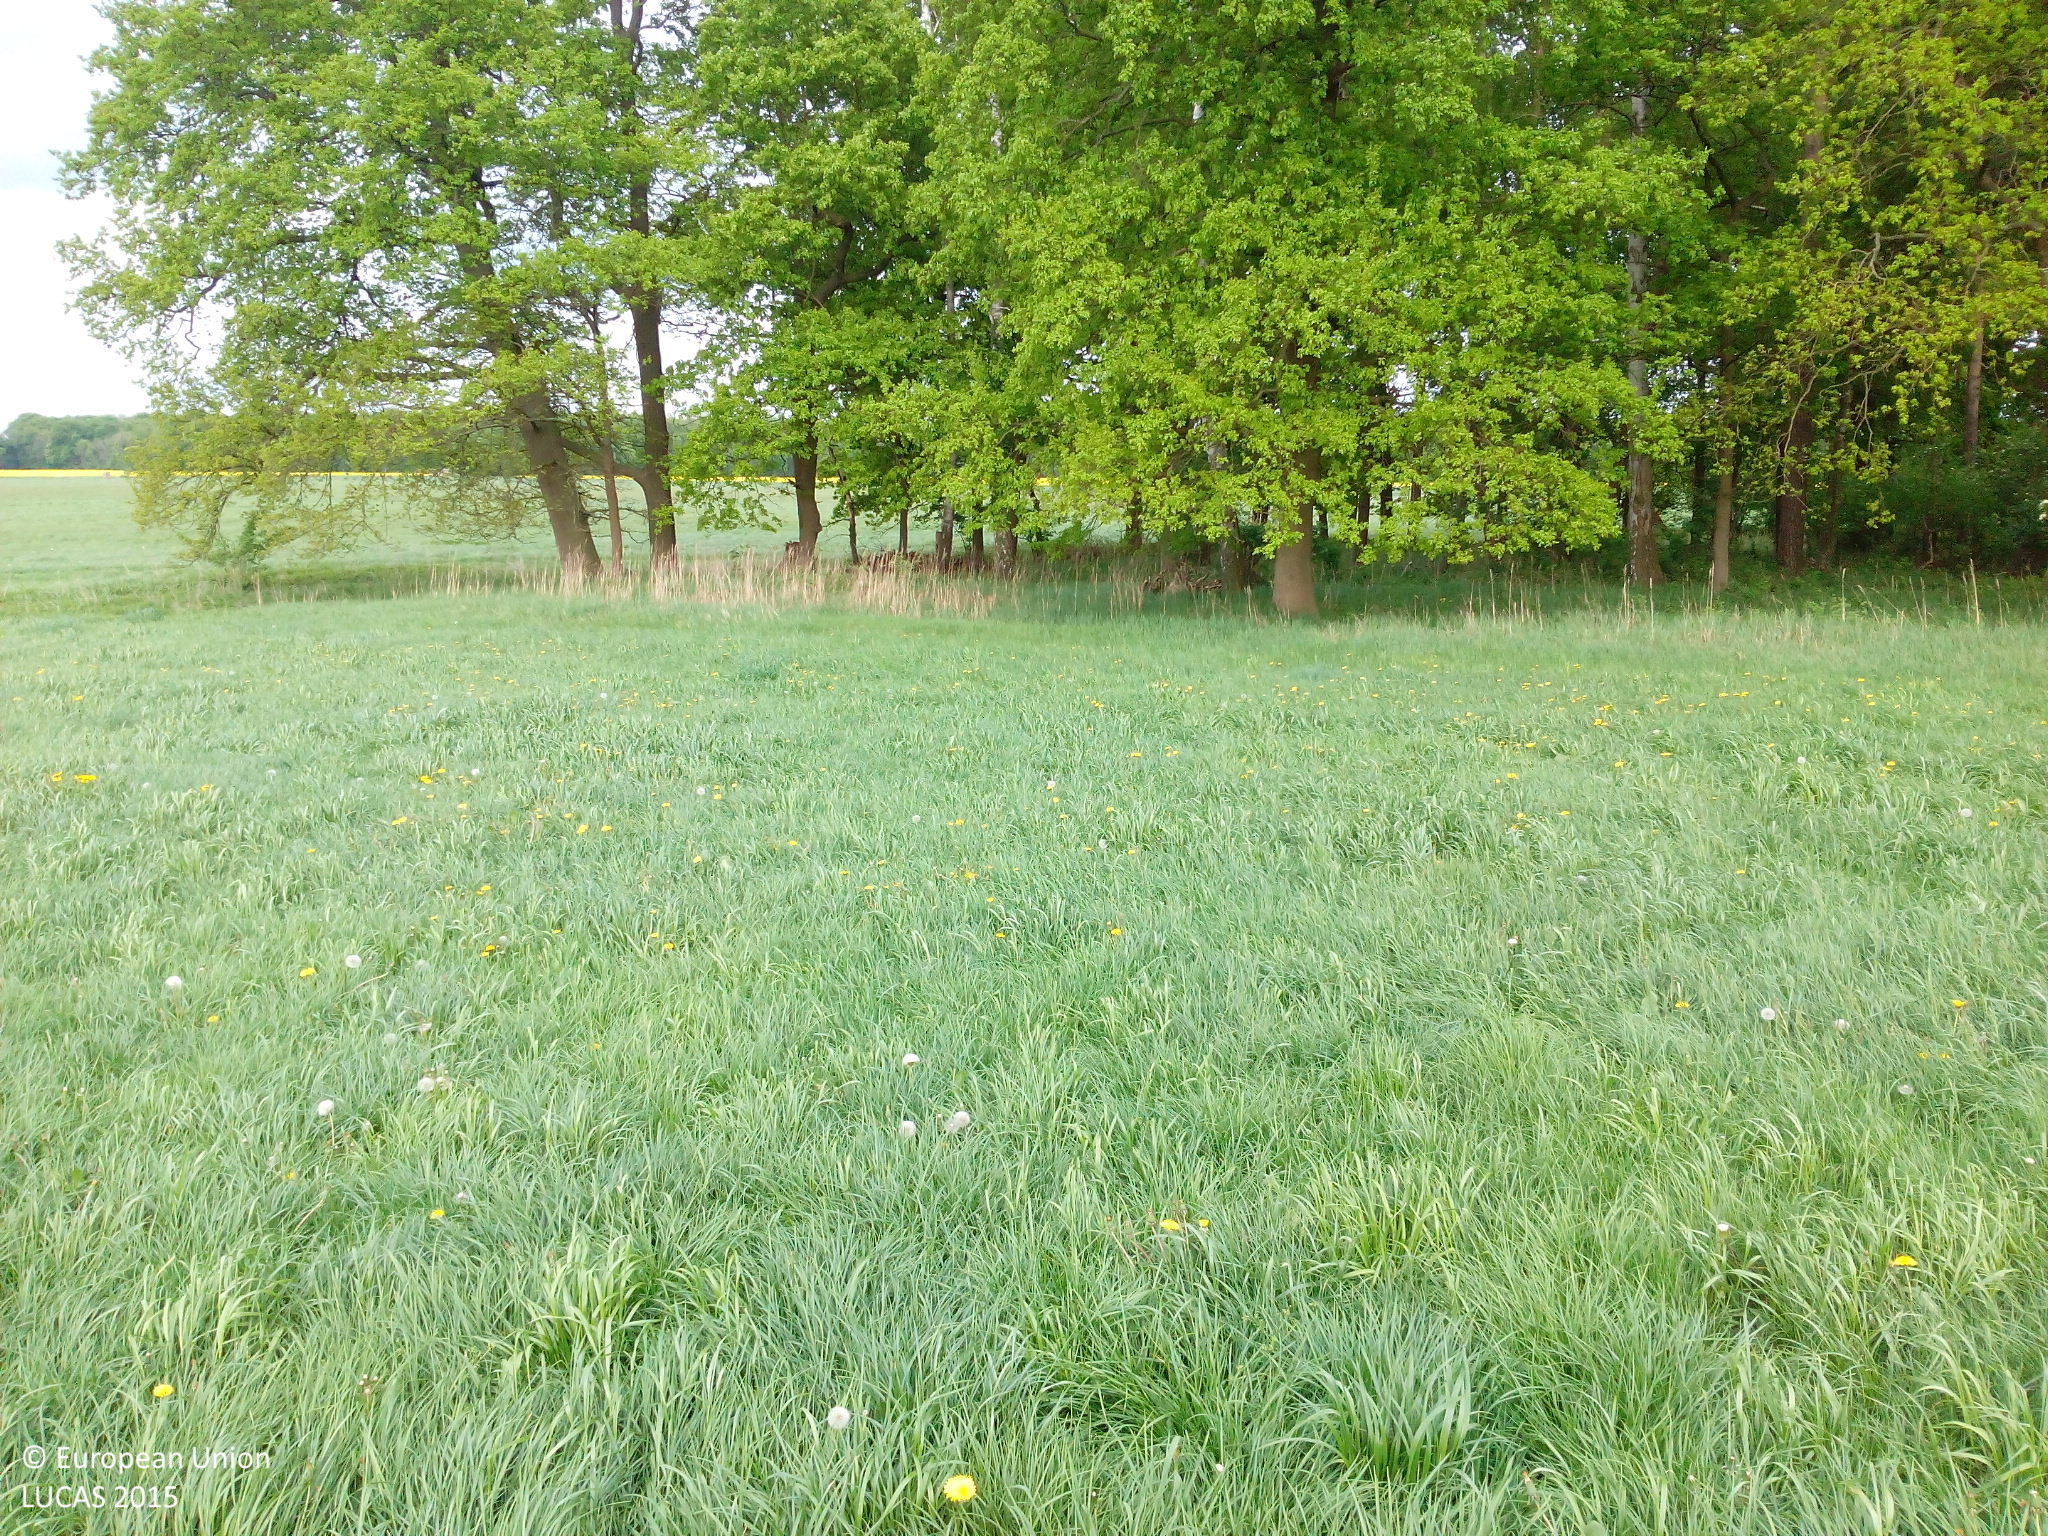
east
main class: Grassland
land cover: Grassland without tree/shrub cover
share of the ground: > 75 %
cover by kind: herbaceous plants 100 %
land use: Agriculture (excluding fallow land and kitchen gardens)
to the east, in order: Grassland without tree/shrub cover; Broadleaved woodland; Grassland without tree/shrub cover
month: May
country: DE
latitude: 52.8518
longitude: 11.6181
